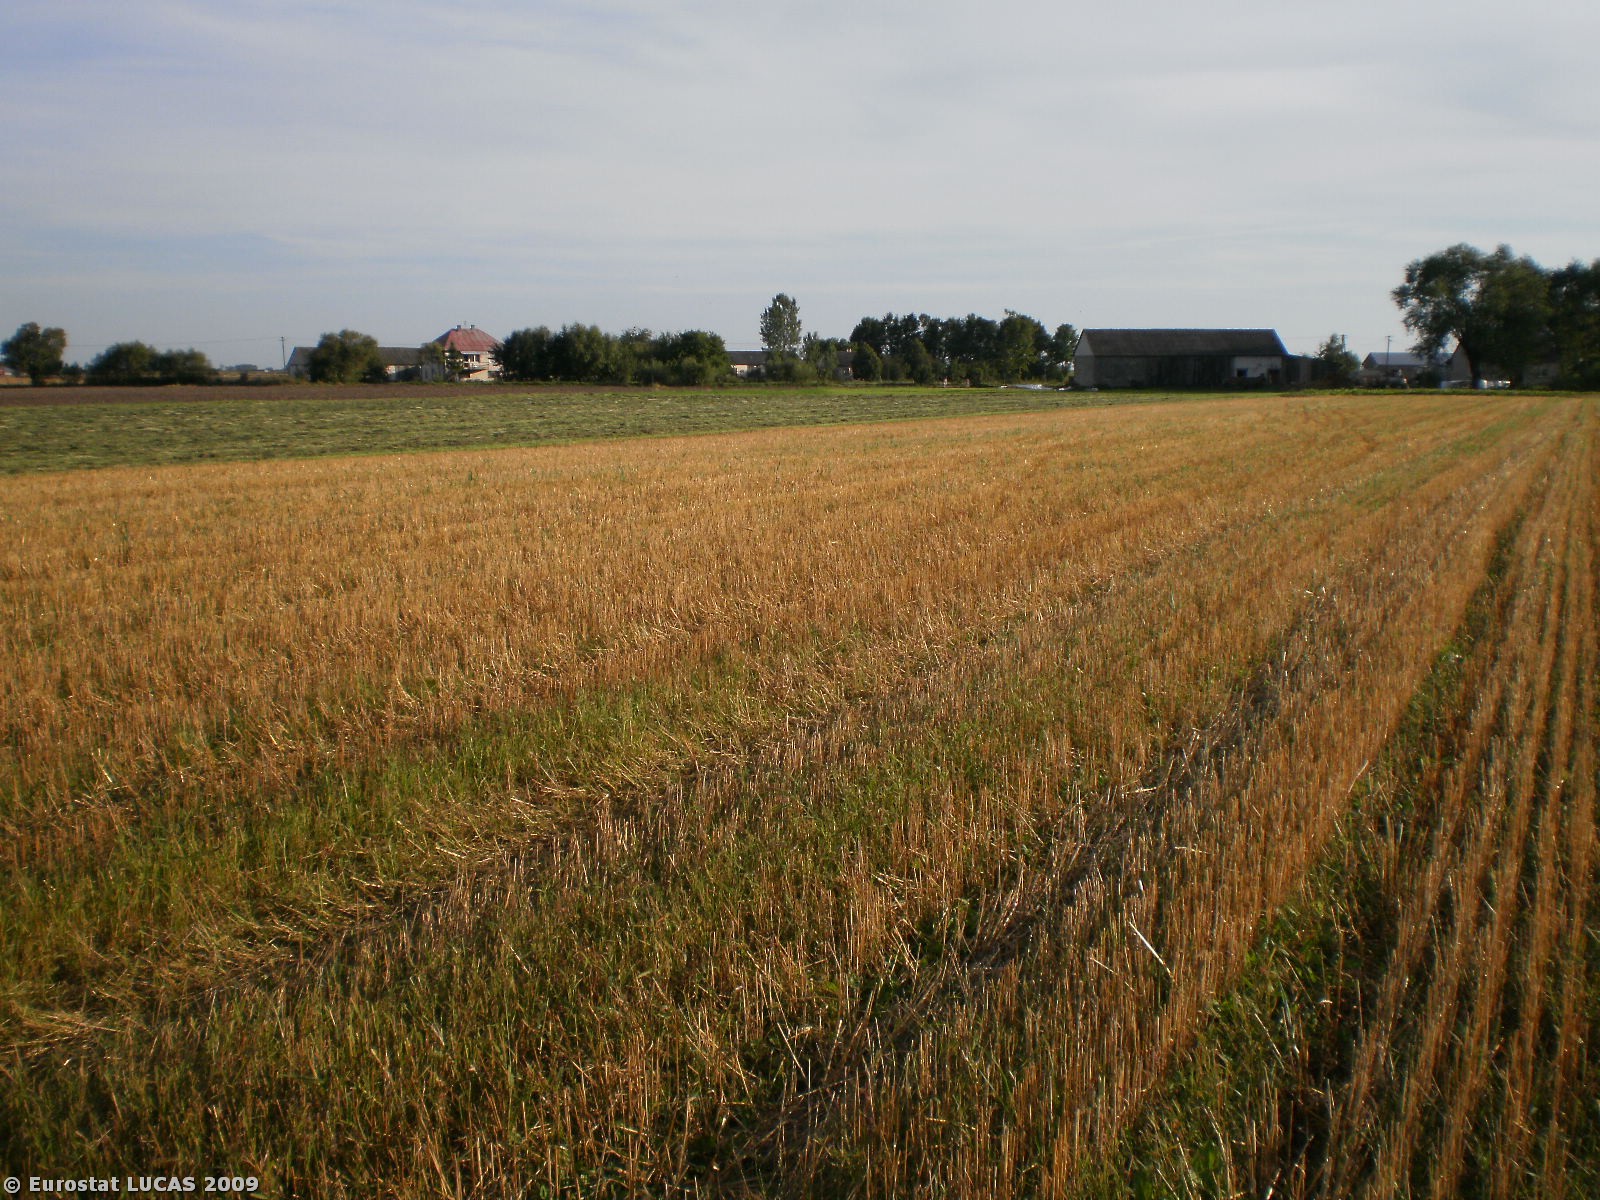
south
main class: Cropland
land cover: Mixed cereals for fodder
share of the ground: < 10 %
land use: Agriculture (excluding fallow land and kitchen gardens)
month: August
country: PL
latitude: 52.8646
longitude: 22.1064
